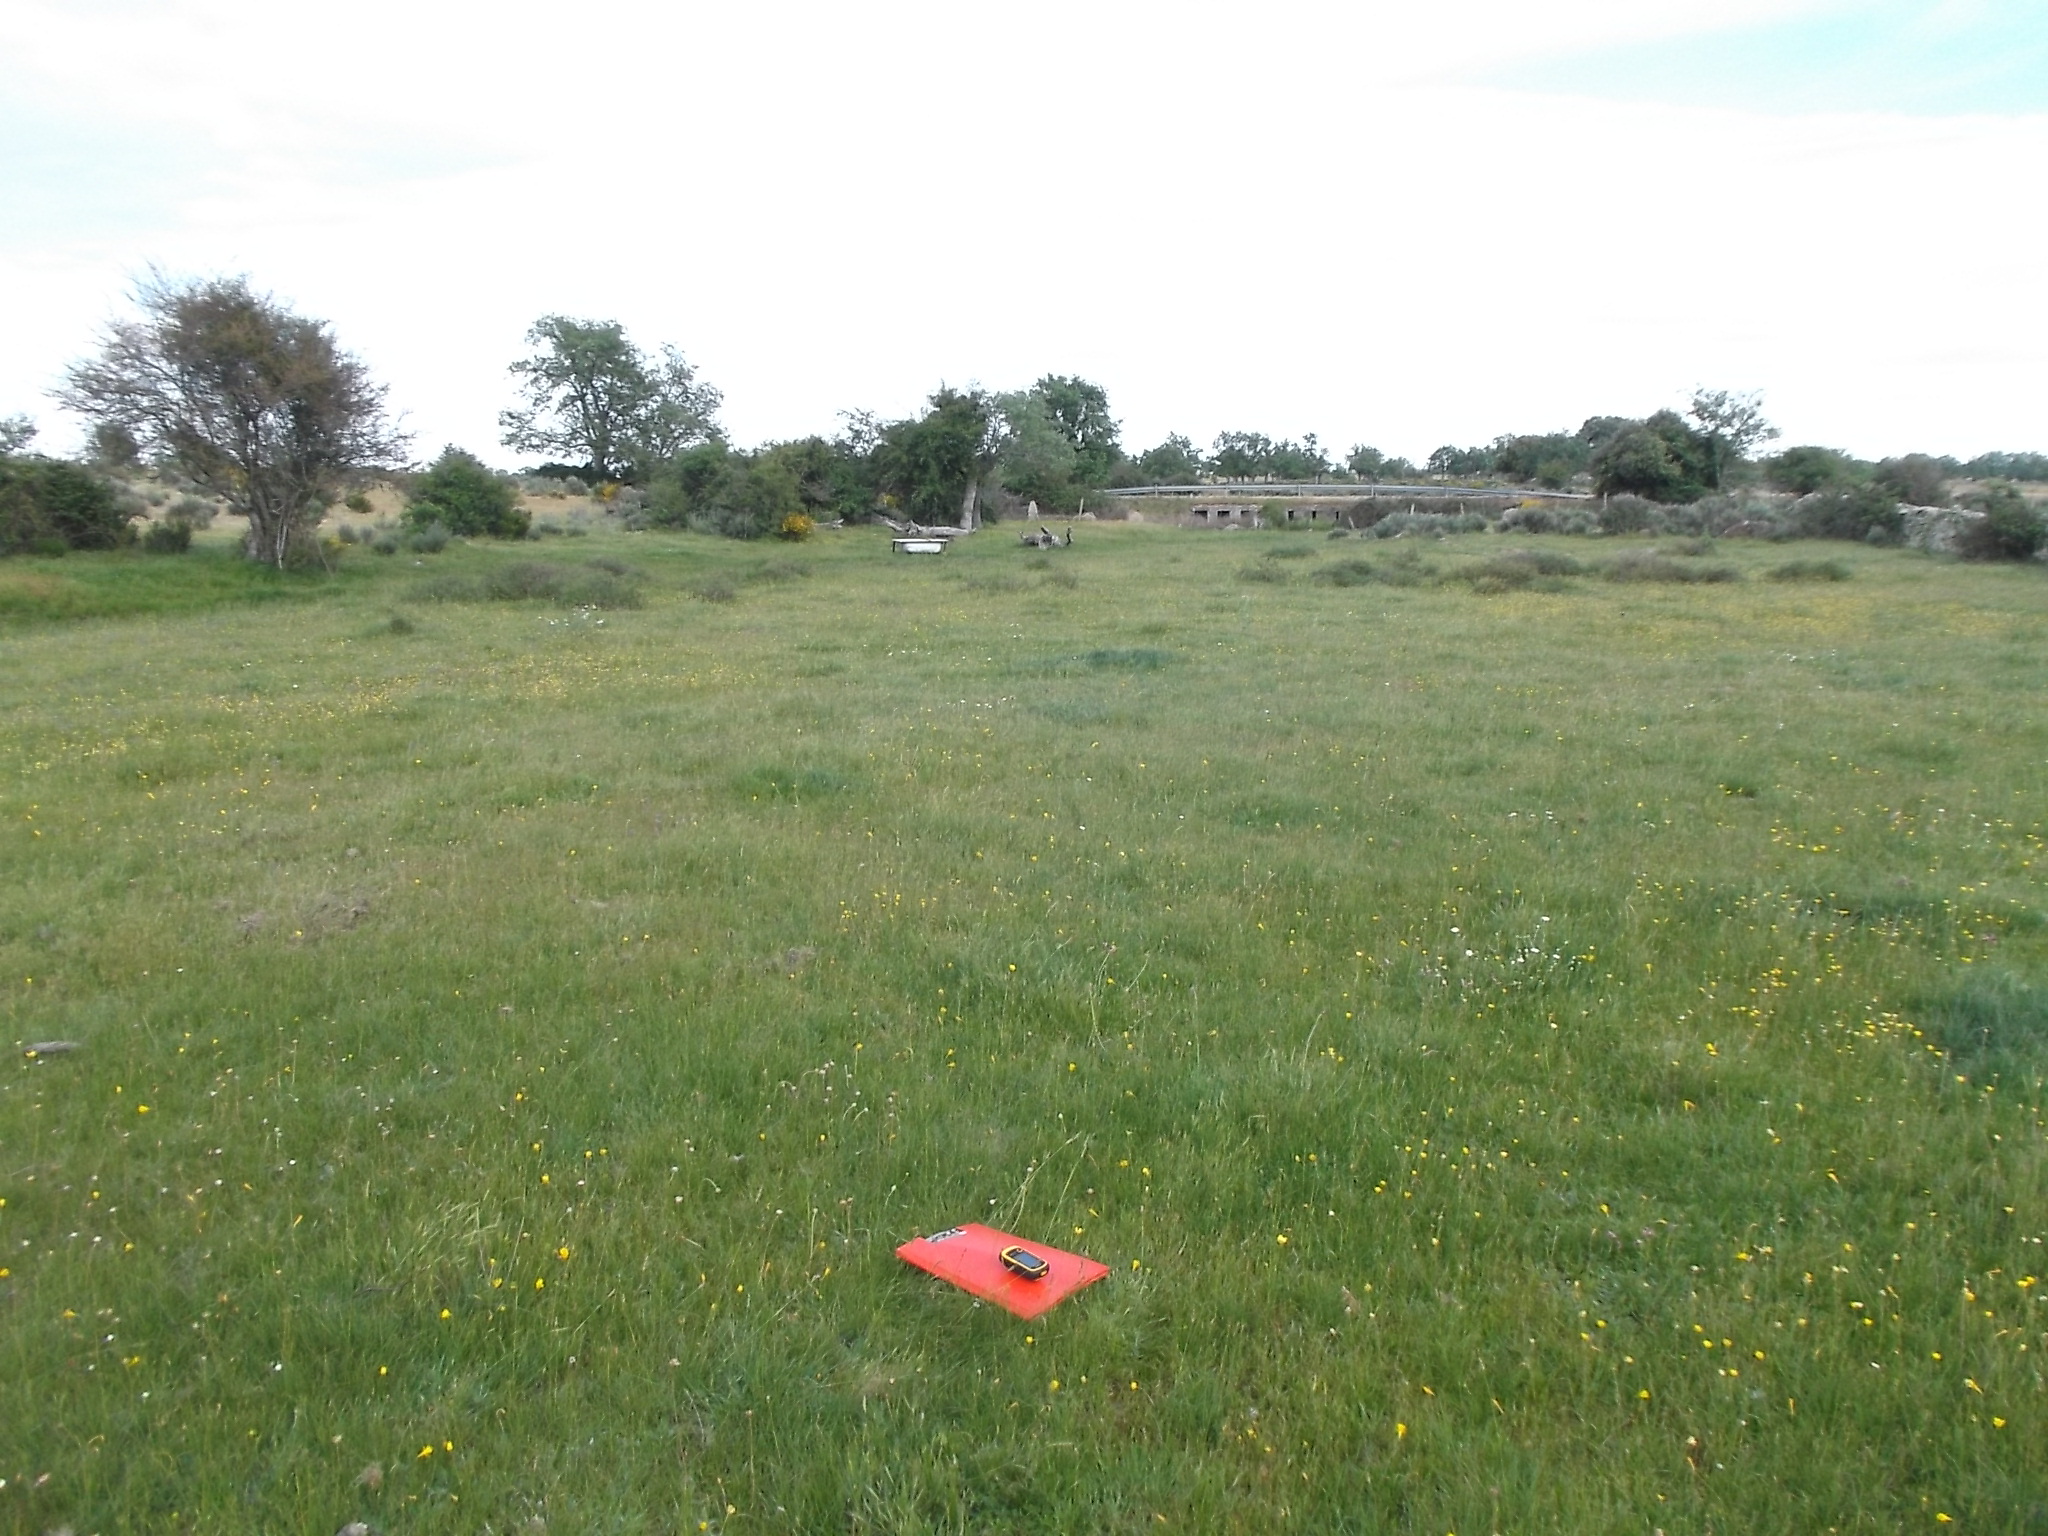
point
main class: Grassland
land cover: Grassland without tree/shrub cover
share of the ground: > 75 %
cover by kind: herbaceous plants 100 %
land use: Agriculture (excluding fallow land and kitchen gardens)
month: May
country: ES
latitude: 41.1557
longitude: -6.3119
